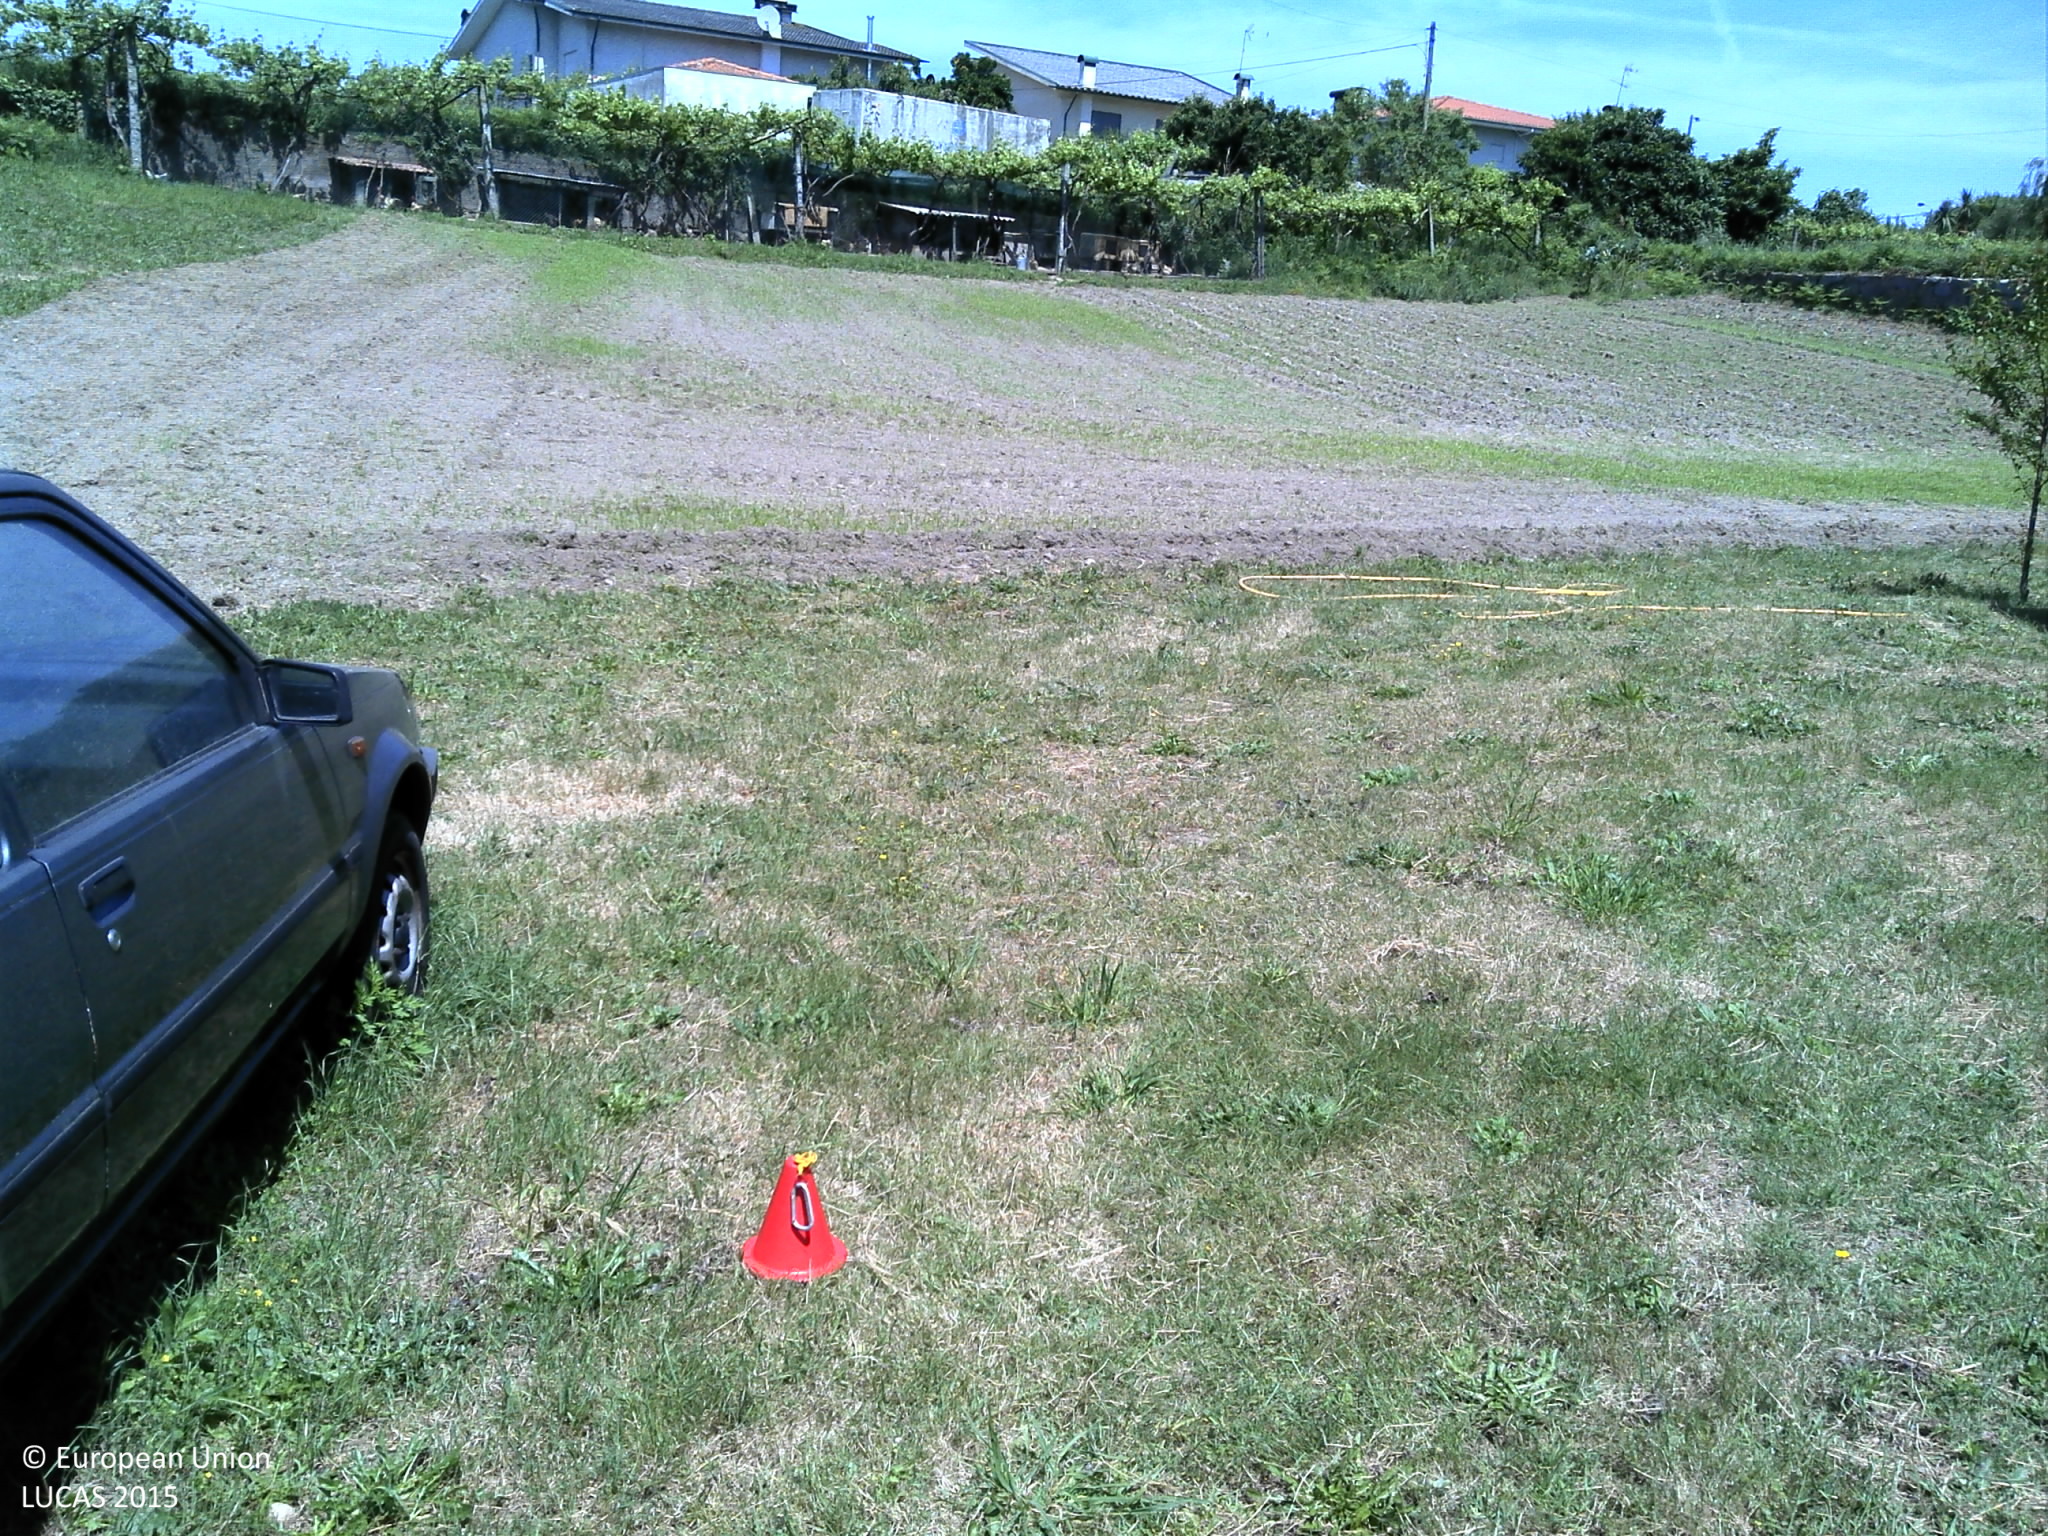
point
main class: Grassland
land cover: Grassland without tree/shrub cover
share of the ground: 50 - 75 %
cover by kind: herbaceous plants 75 %, consolidated bare surface 25 %
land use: Agriculture (excluding fallow land and kitchen gardens)
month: May
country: PT
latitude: 41.3788
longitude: -8.4831
